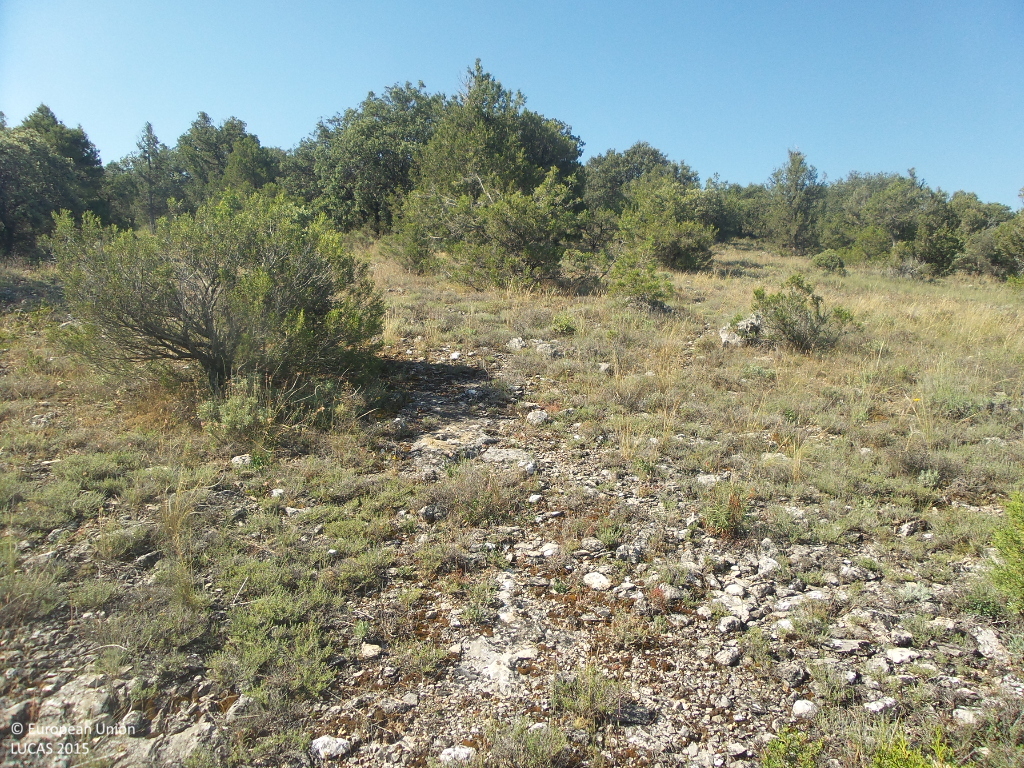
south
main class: Woodland
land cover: Other mixed woodland
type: coniferous forest of the mediterranean region
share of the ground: 50 - 75 %
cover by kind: coniferous forest trees 25 %, broadleaved forest trees 25 %, shrubs 25 %, unconsolidated bare surface 20 %, herbaceous plants 5 %
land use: Semi-natural and natural areas not in use
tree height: < 5 m
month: June
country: ES
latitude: 41.4494
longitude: -2.9804
